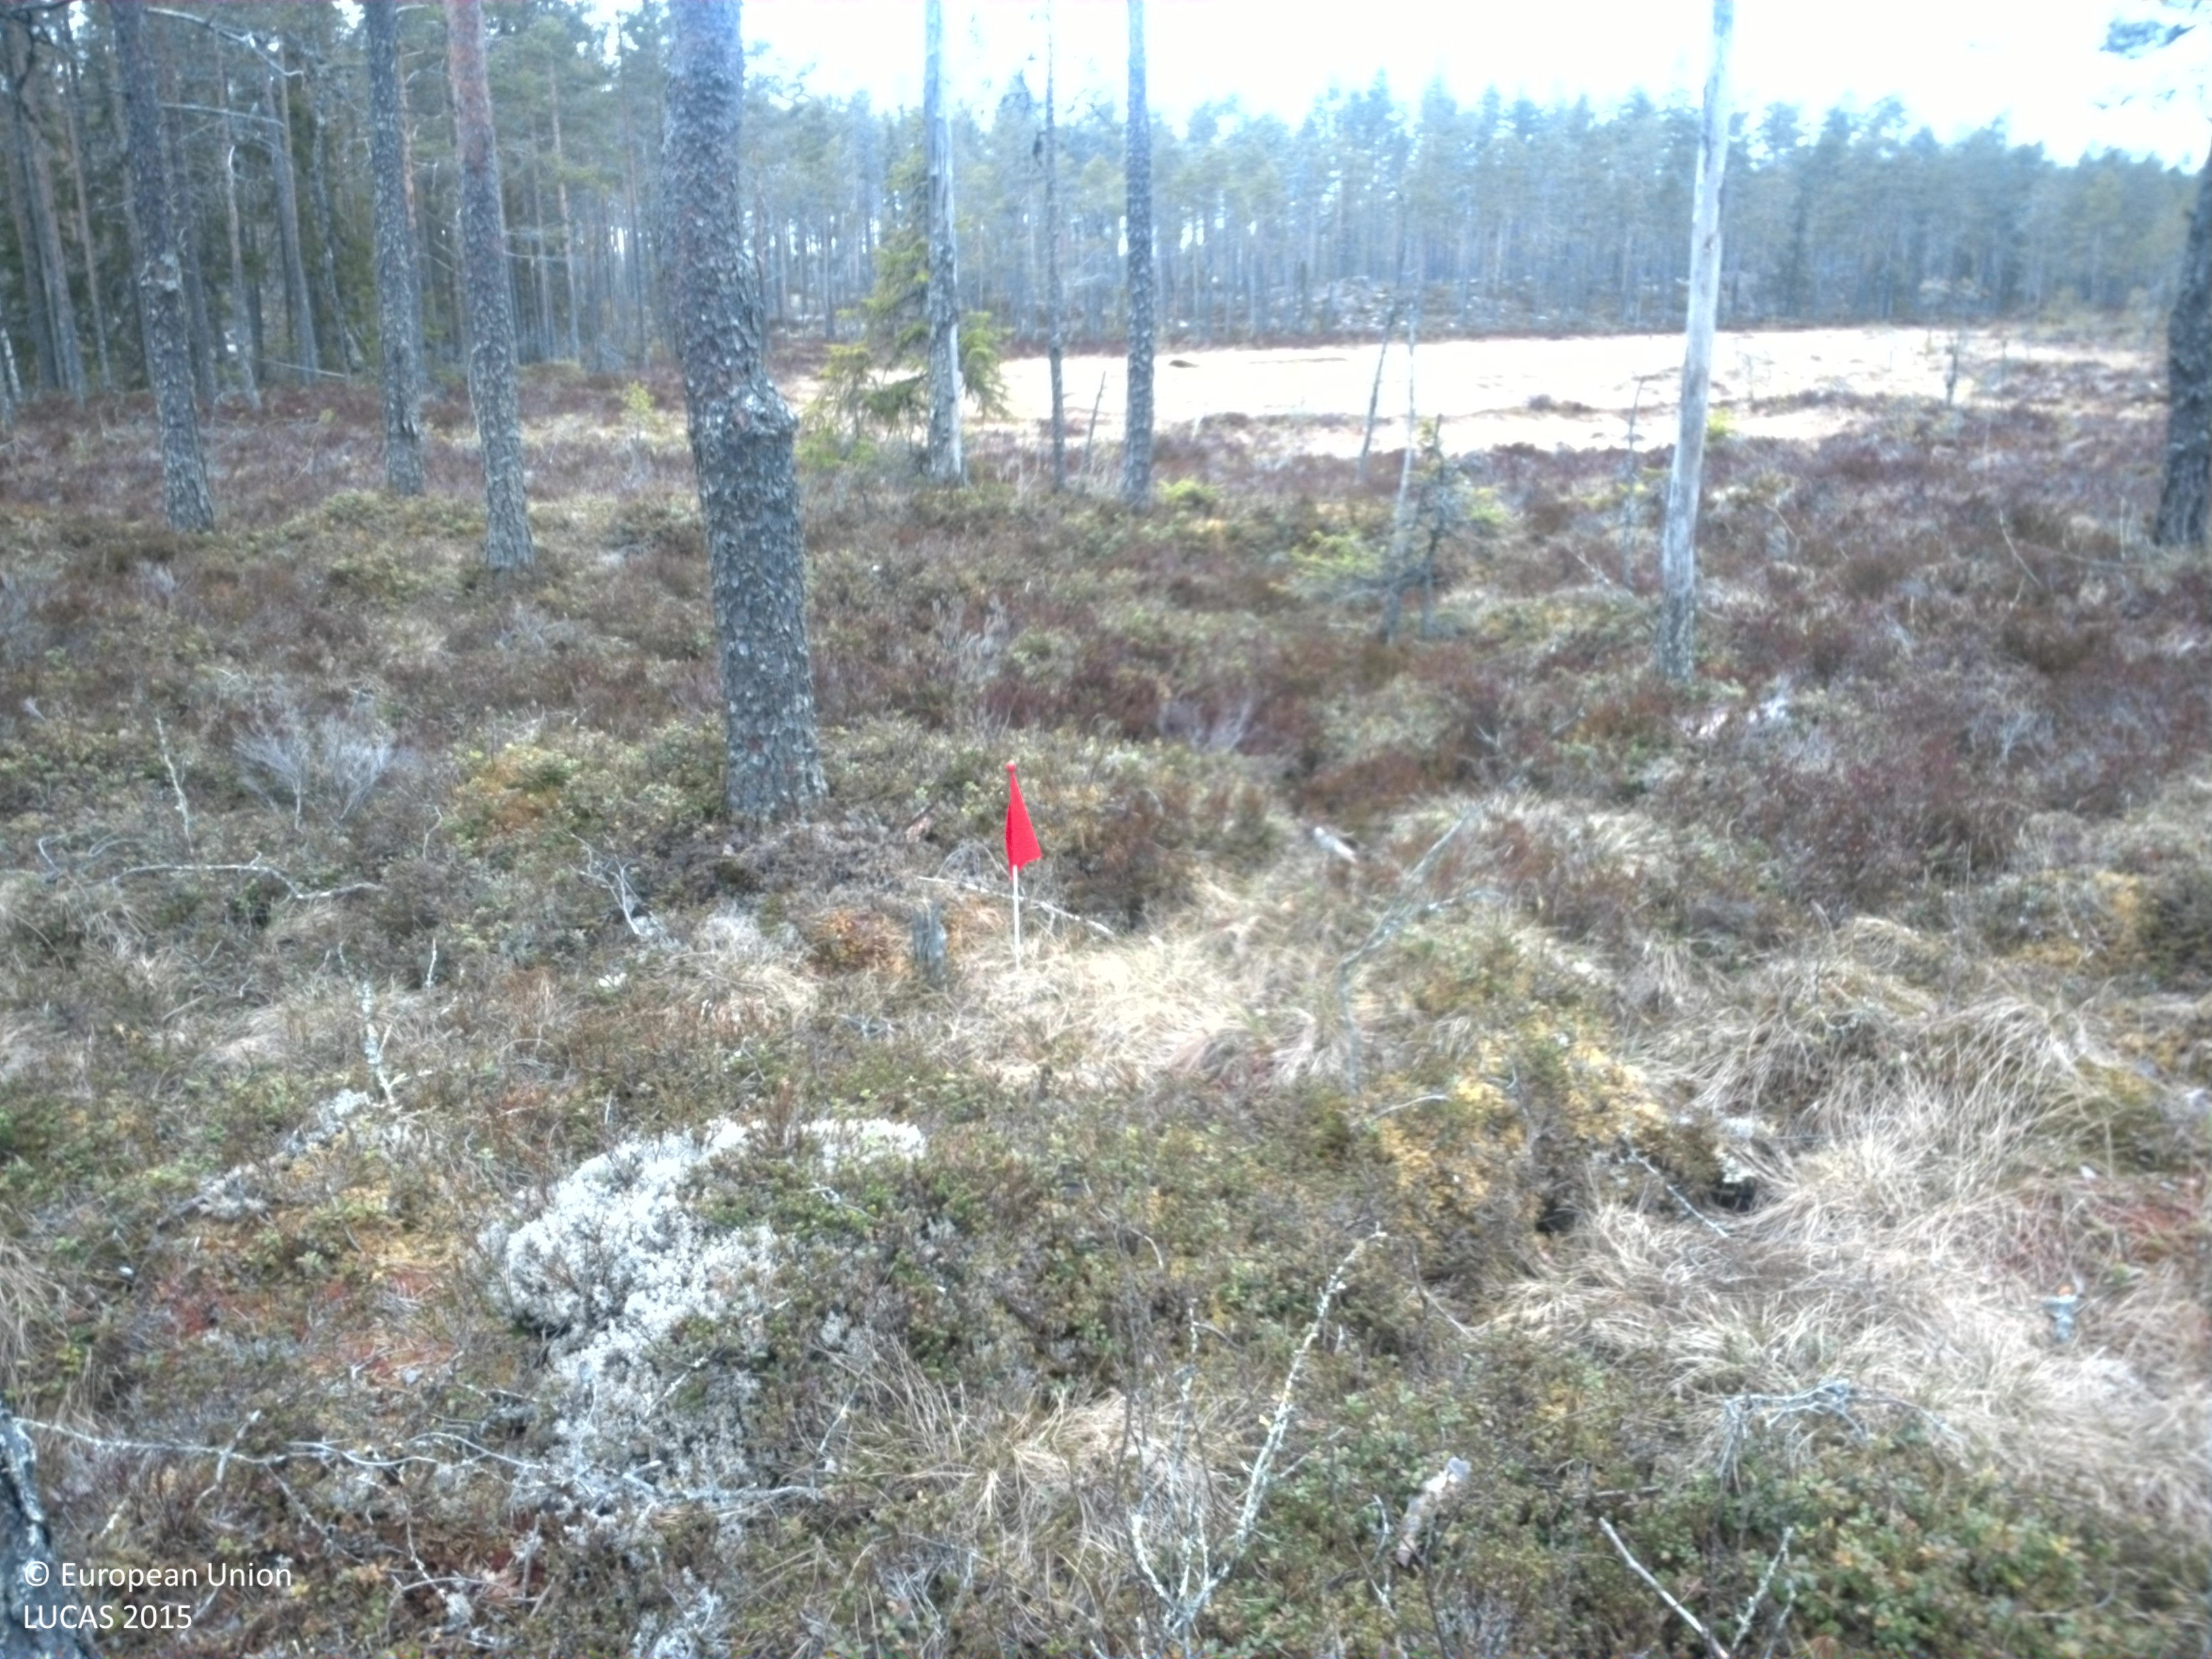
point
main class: Woodland
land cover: Pine dominated coniferous woodland
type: boreal forest
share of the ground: 25 - 50 %
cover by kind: coniferous forest trees 45 %, shrubs 25 %, lichens and mosses 25 %, herbaceous plants 5 %
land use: Forestry
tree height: > 5 m
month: May
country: SE
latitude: 60.9163
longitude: 13.3272
